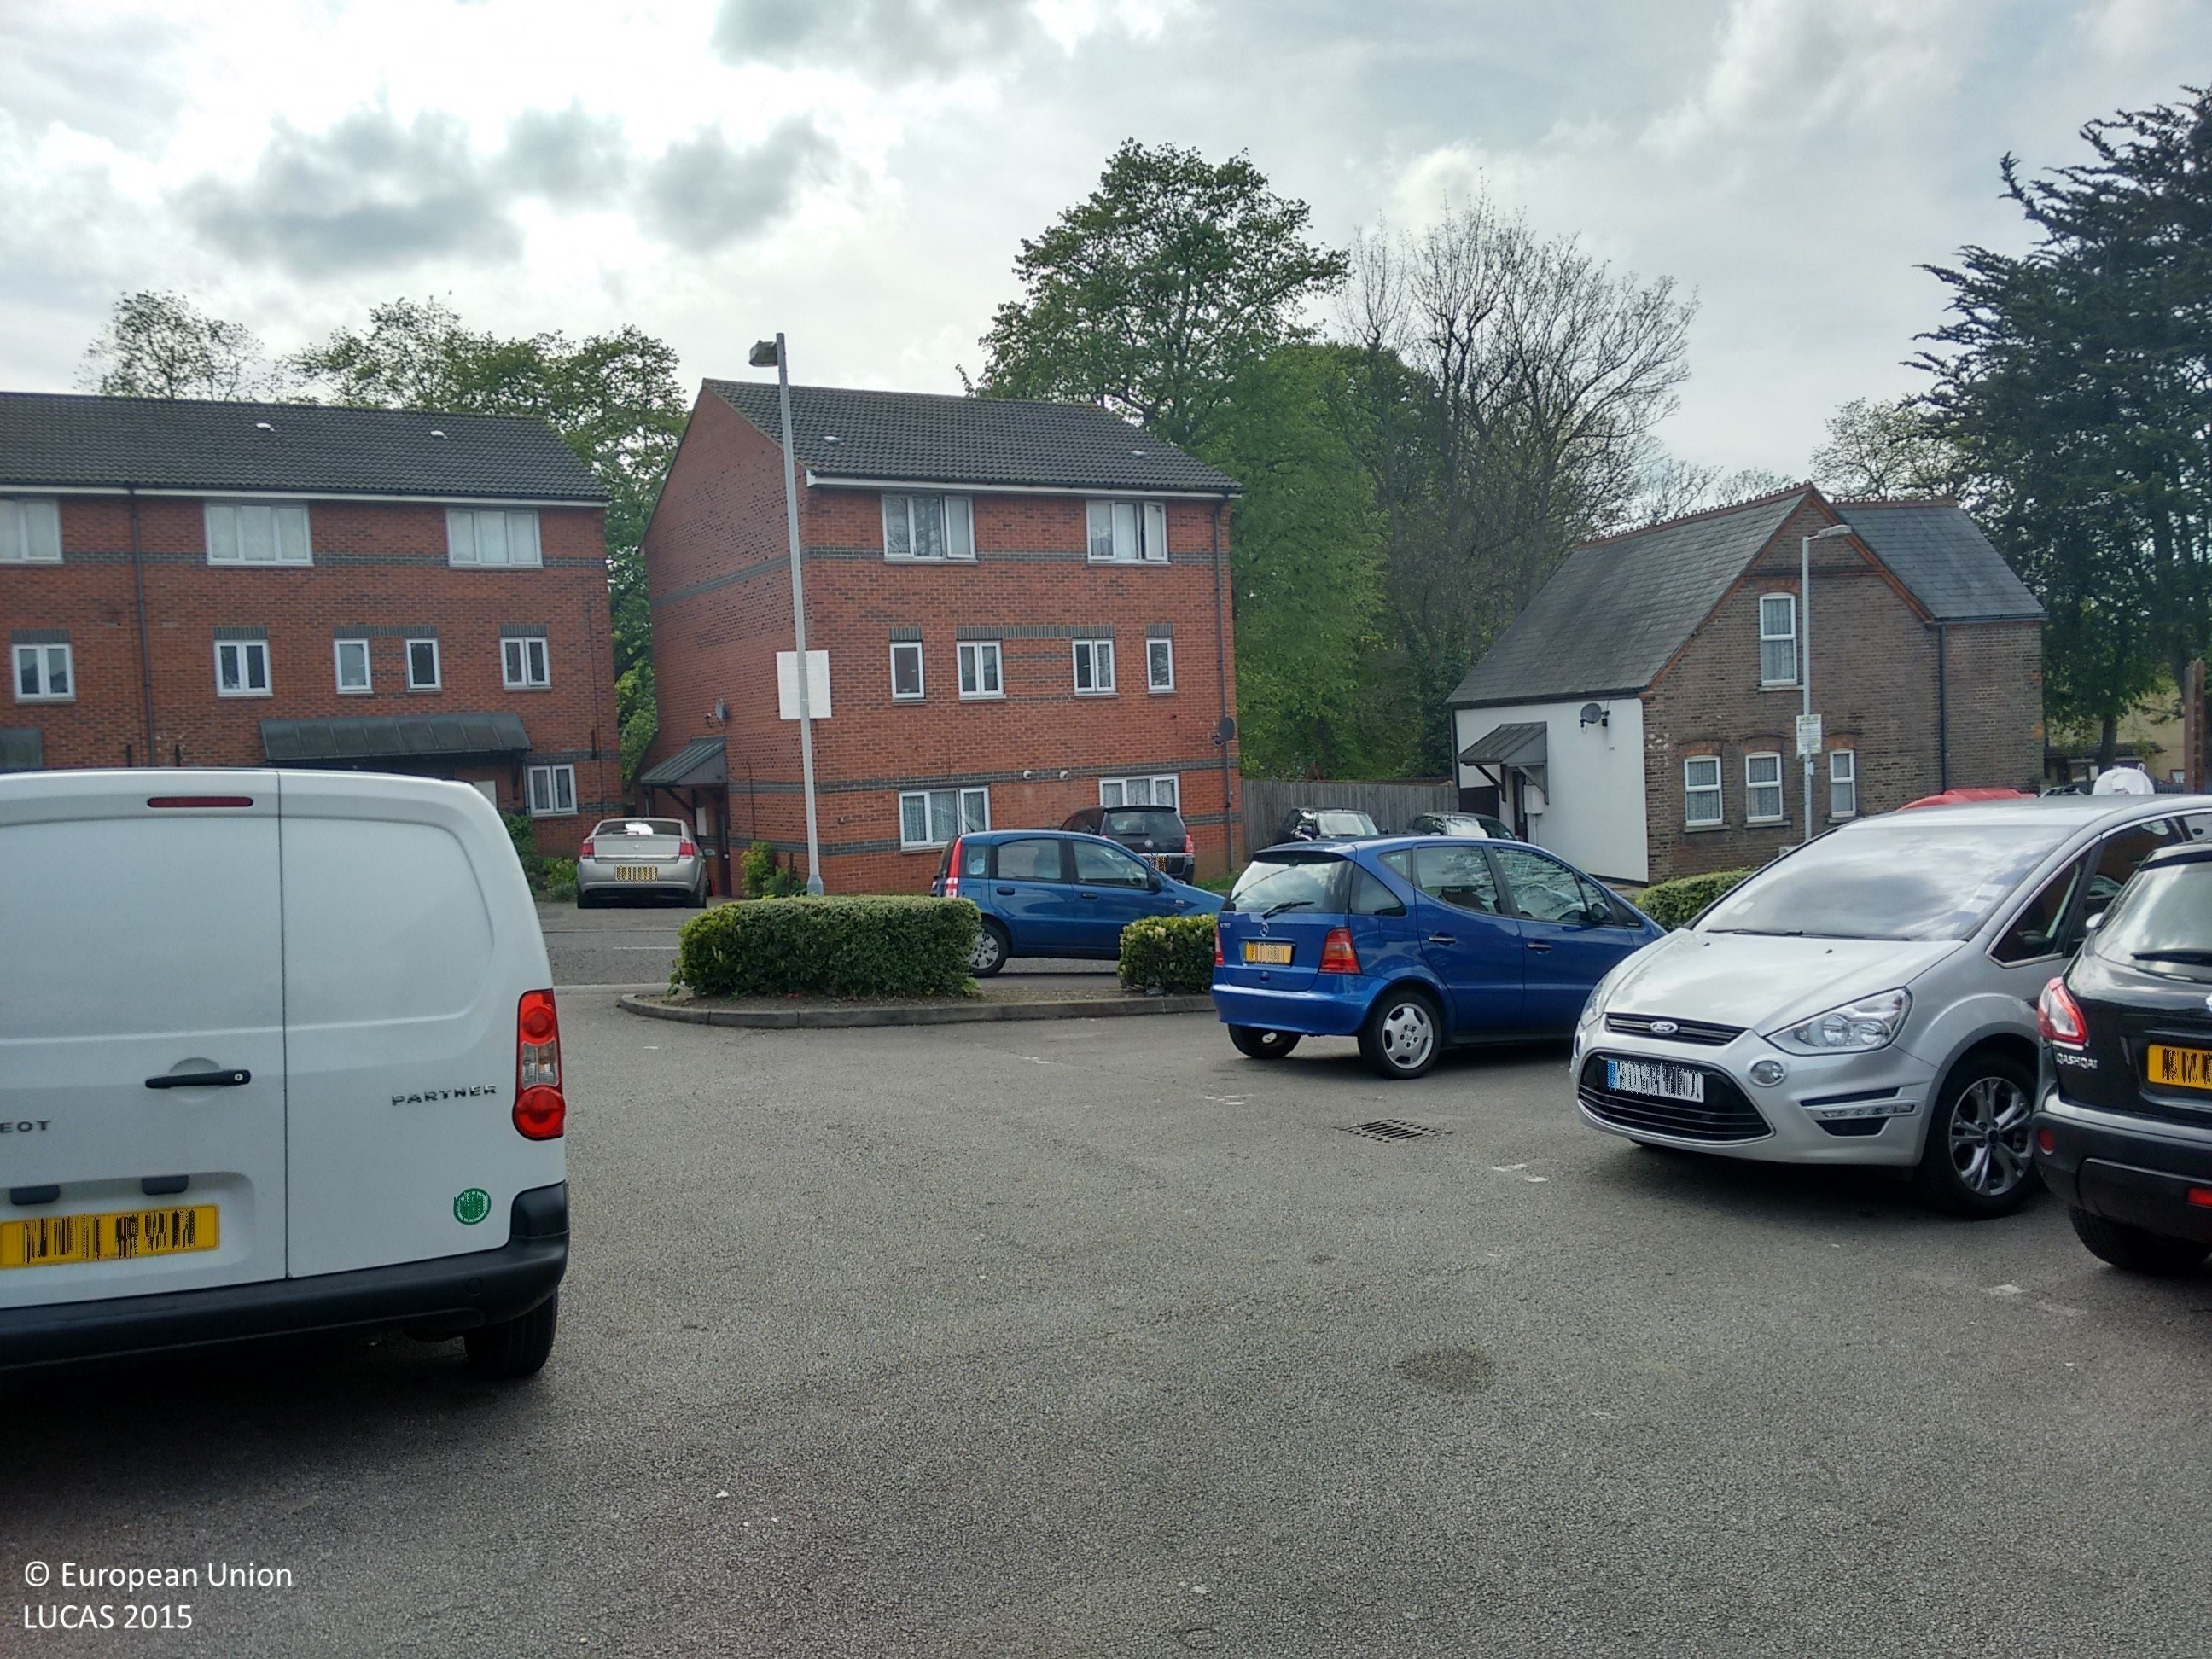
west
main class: Grassland
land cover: Grassland without tree/shrub cover
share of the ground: > 75 %
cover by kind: herbaceous plants 80 %, consolidated bare surface 20 %
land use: Residential
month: May
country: GB
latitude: 51.8810
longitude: -0.4244
